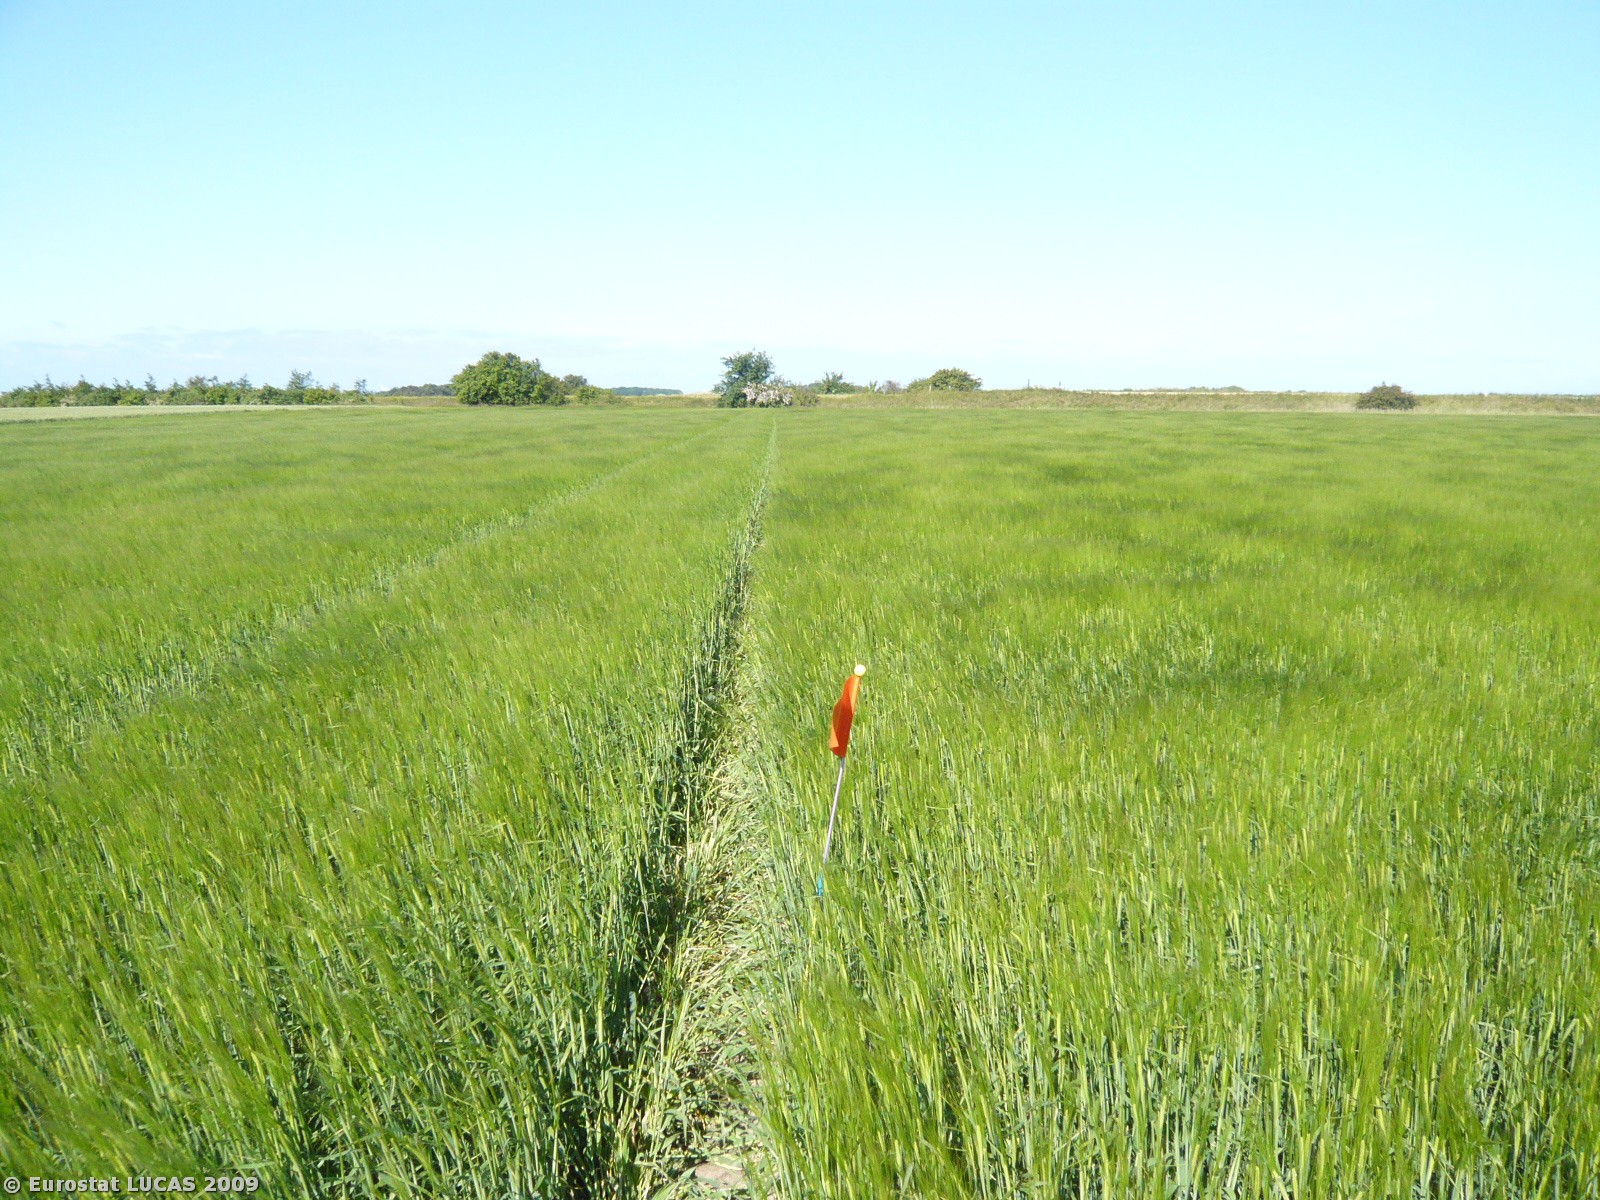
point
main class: Cropland
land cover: Barley
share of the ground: > 75 %
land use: Agriculture (excluding fallow land and kitchen gardens)
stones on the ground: < 10 %
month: June
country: DK
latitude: 54.7991
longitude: 11.0725
